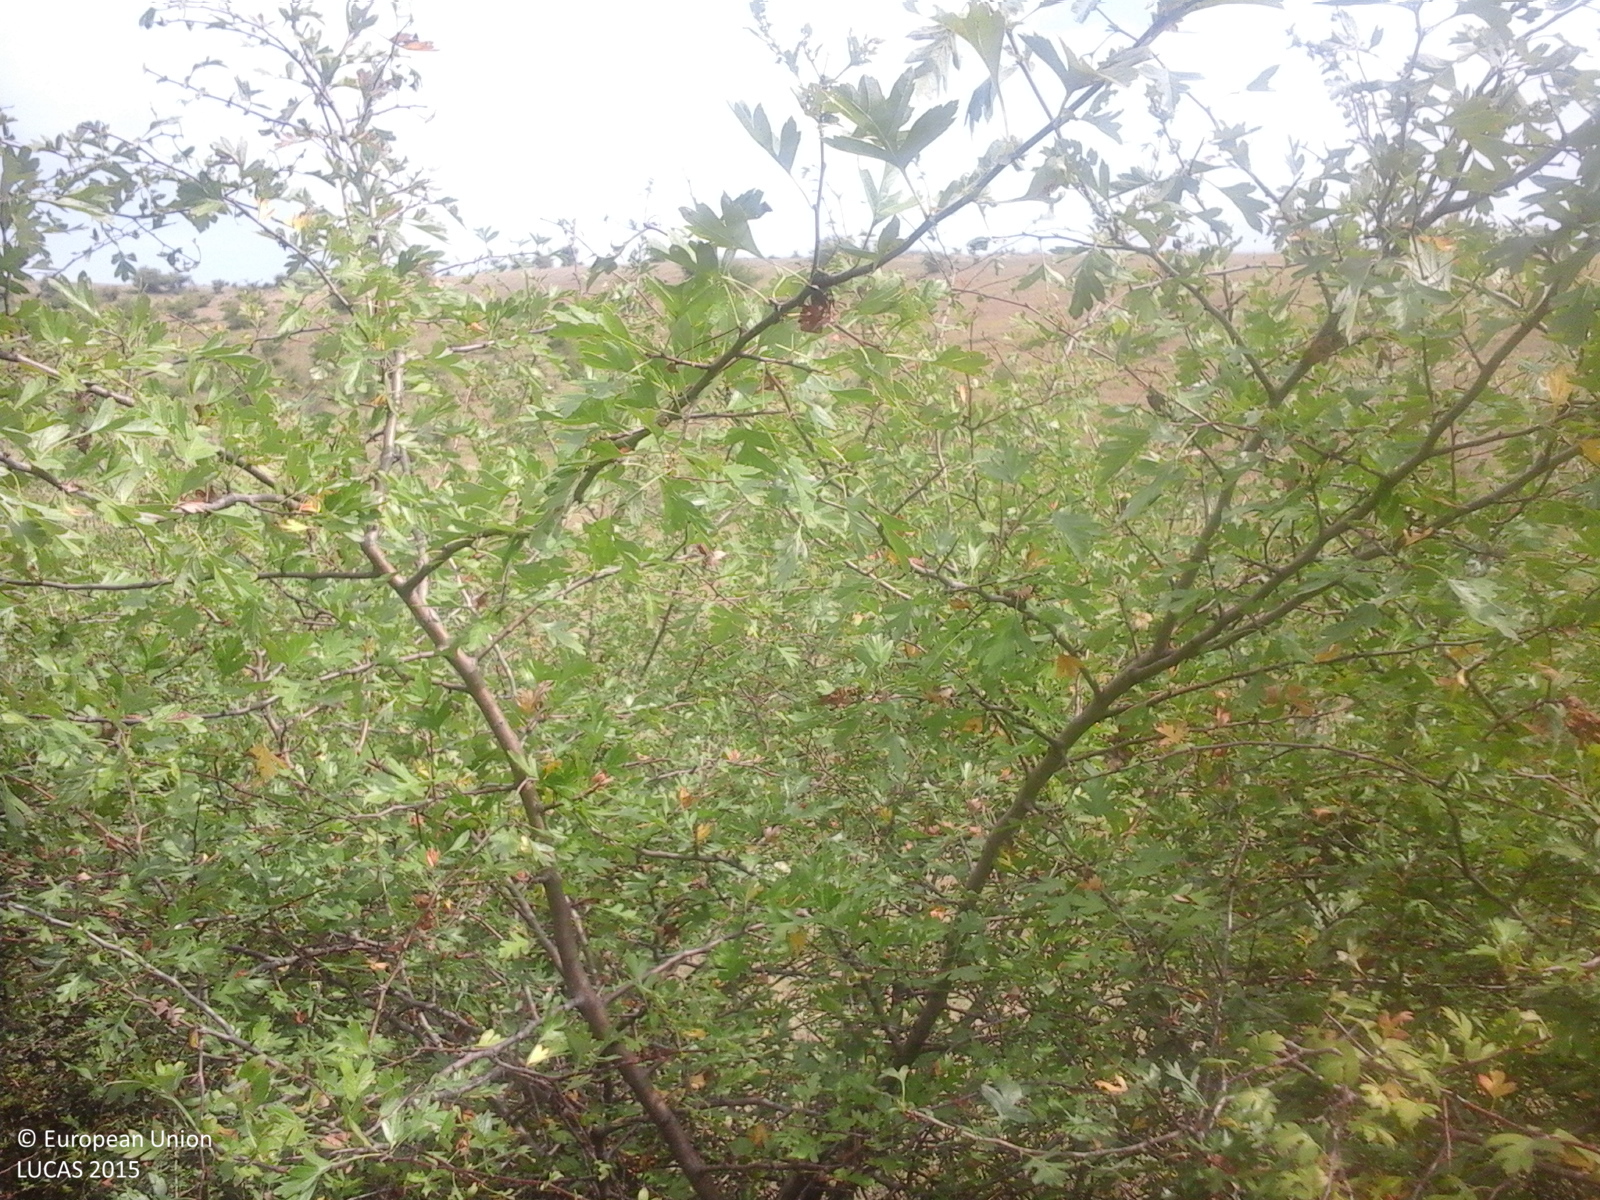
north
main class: Shrubland
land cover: Shrubland with sparse tree cover
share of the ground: > 75 %
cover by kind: herbaceous plants 85 %, shrubs 10 %, broadleaved forest trees 5 %
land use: Fallow land
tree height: > 5 m
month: August
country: RO
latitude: 44.0704
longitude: 27.7886
